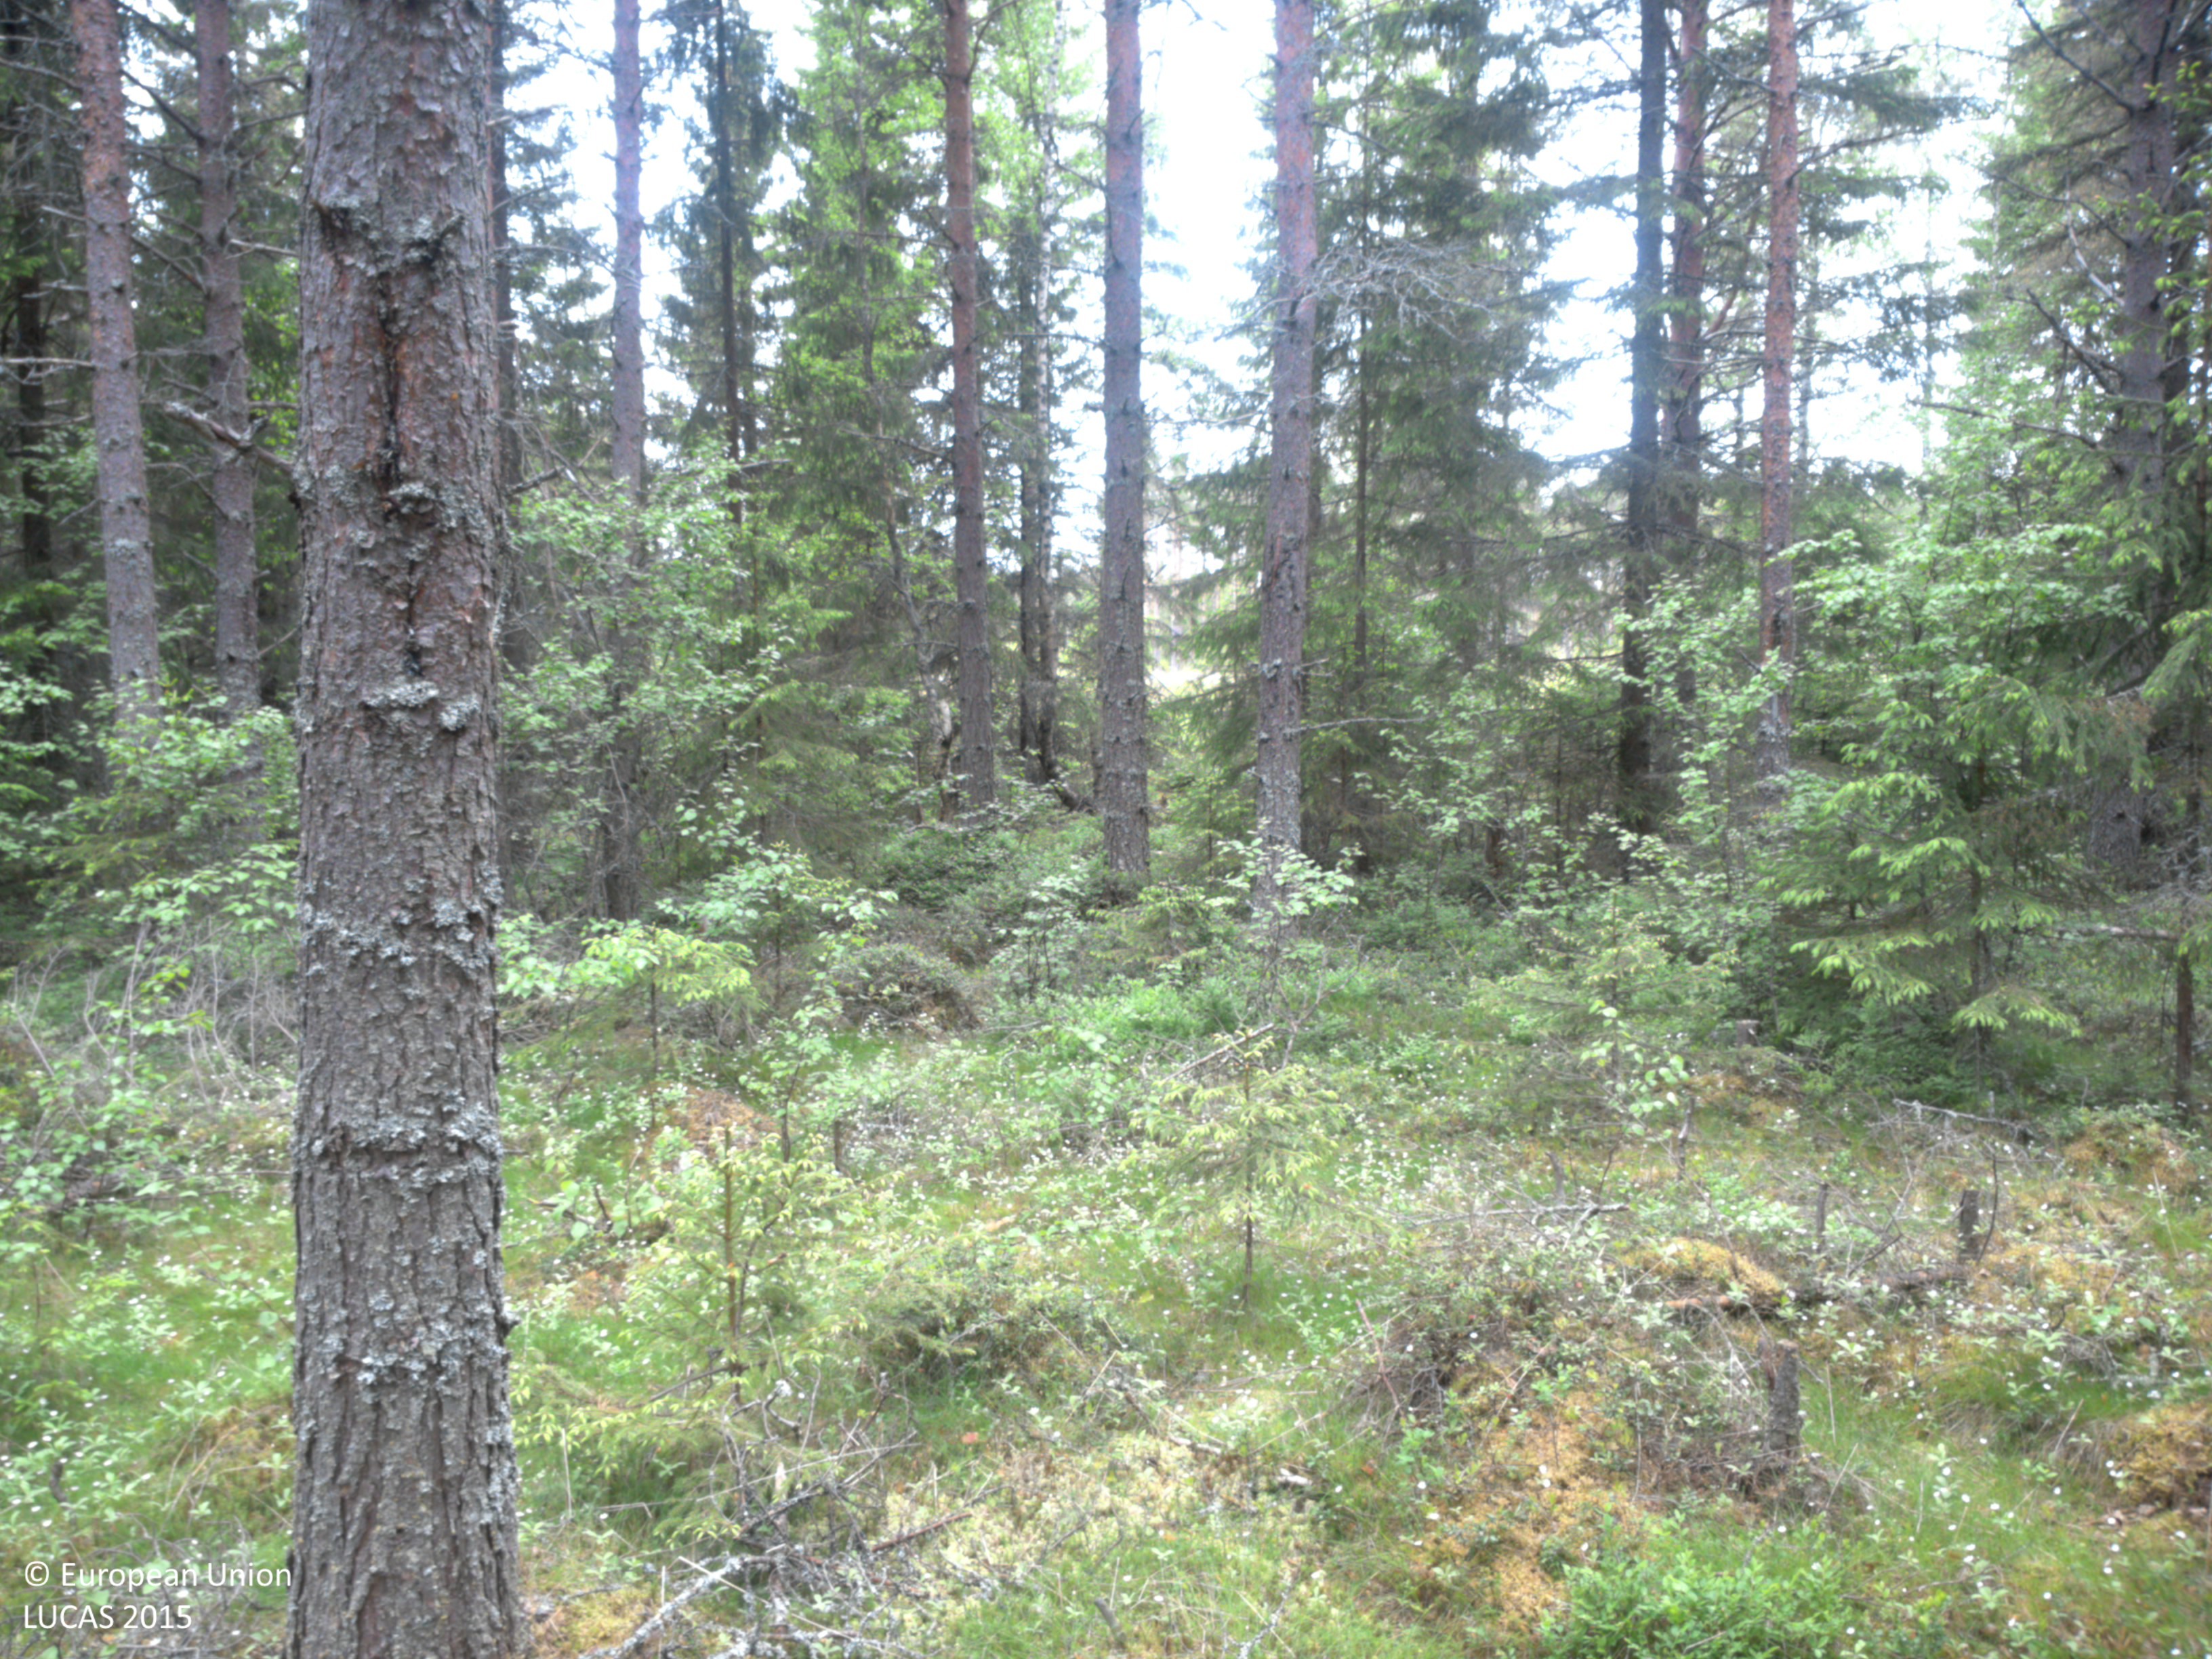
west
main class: Woodland
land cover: Other mixed woodland
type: boreal forest
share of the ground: 50 - 75 %
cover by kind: coniferous forest trees 40 %, broadleaved forest trees 25 %, lichens and mosses 20 %, shrubs 15 %
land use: Forestry
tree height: > 5 m
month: June
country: SE
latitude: 63.6283
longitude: 19.9699
